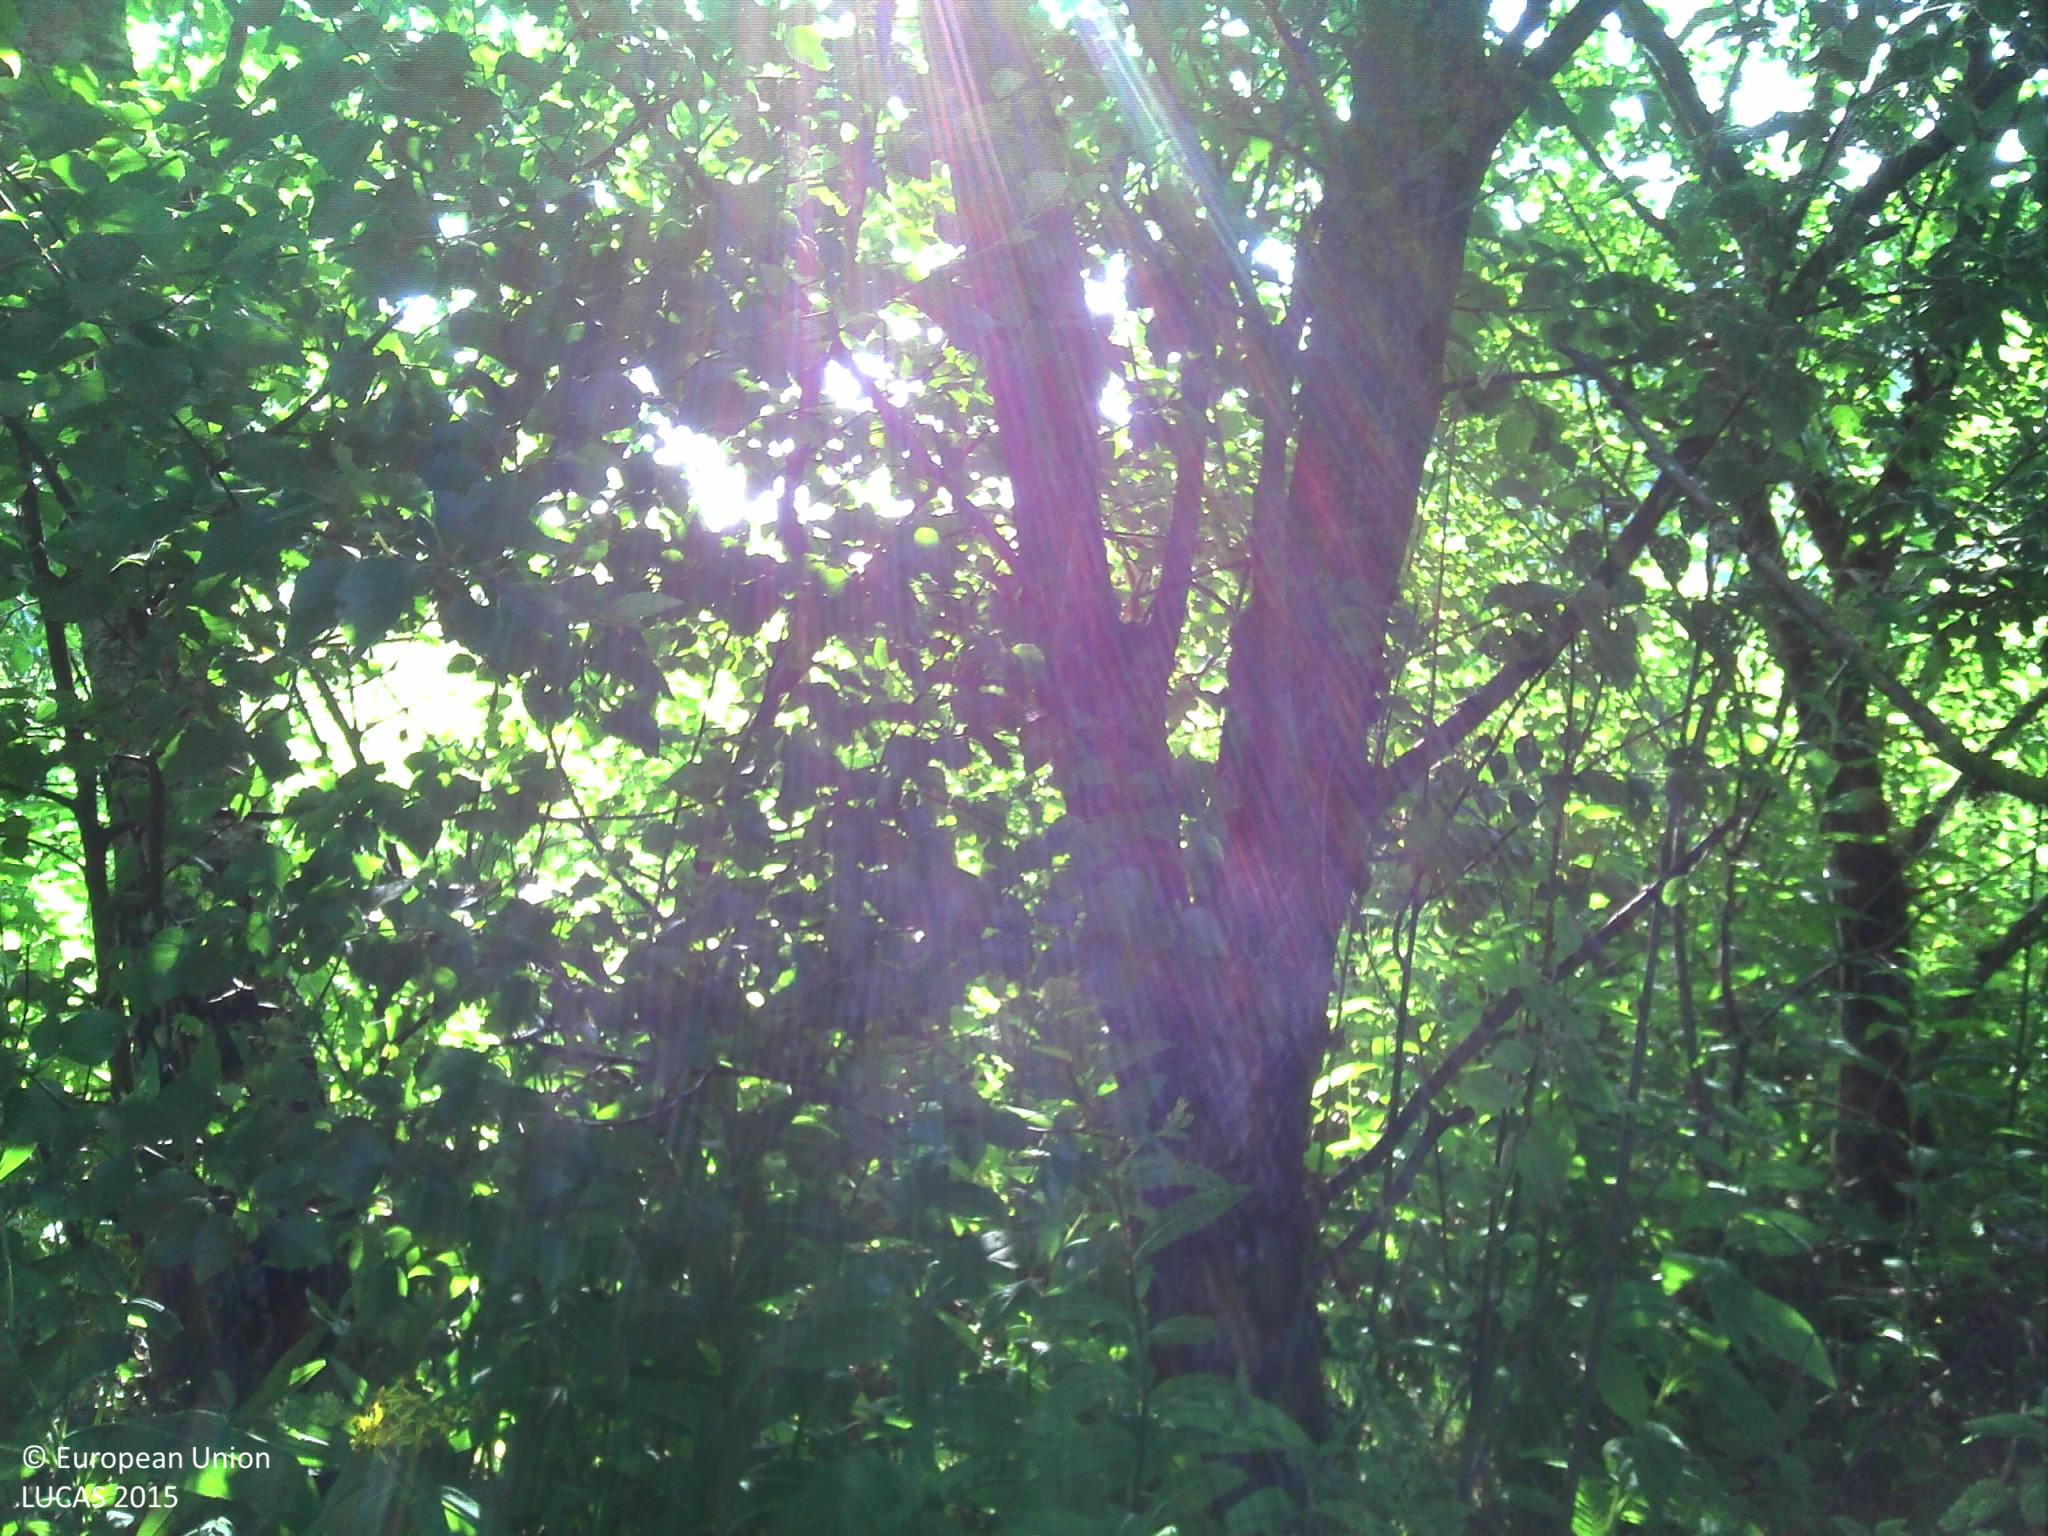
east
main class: Woodland
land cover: Broadleaved woodland
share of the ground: > 75 %
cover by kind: broadleaved forest trees 95 %, herbaceous plants 5 %
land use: Semi-natural and natural areas not in use
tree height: > 5 m
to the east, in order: Broadleaved woodland; Artificial constructions in urban areas; Grassland without tree/shrub cover; Rivers and streams; Grassland without tree/shrub cover; Fences; Grassland without tree/shrub cover; Electric lines; Grassland without tree/shrub cover; Fences; Grass margins; Rivers and streams; Grass margins; Fences; Grassland without tree/shrub cover
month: July
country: BE
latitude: 50.0116
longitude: 5.6588
